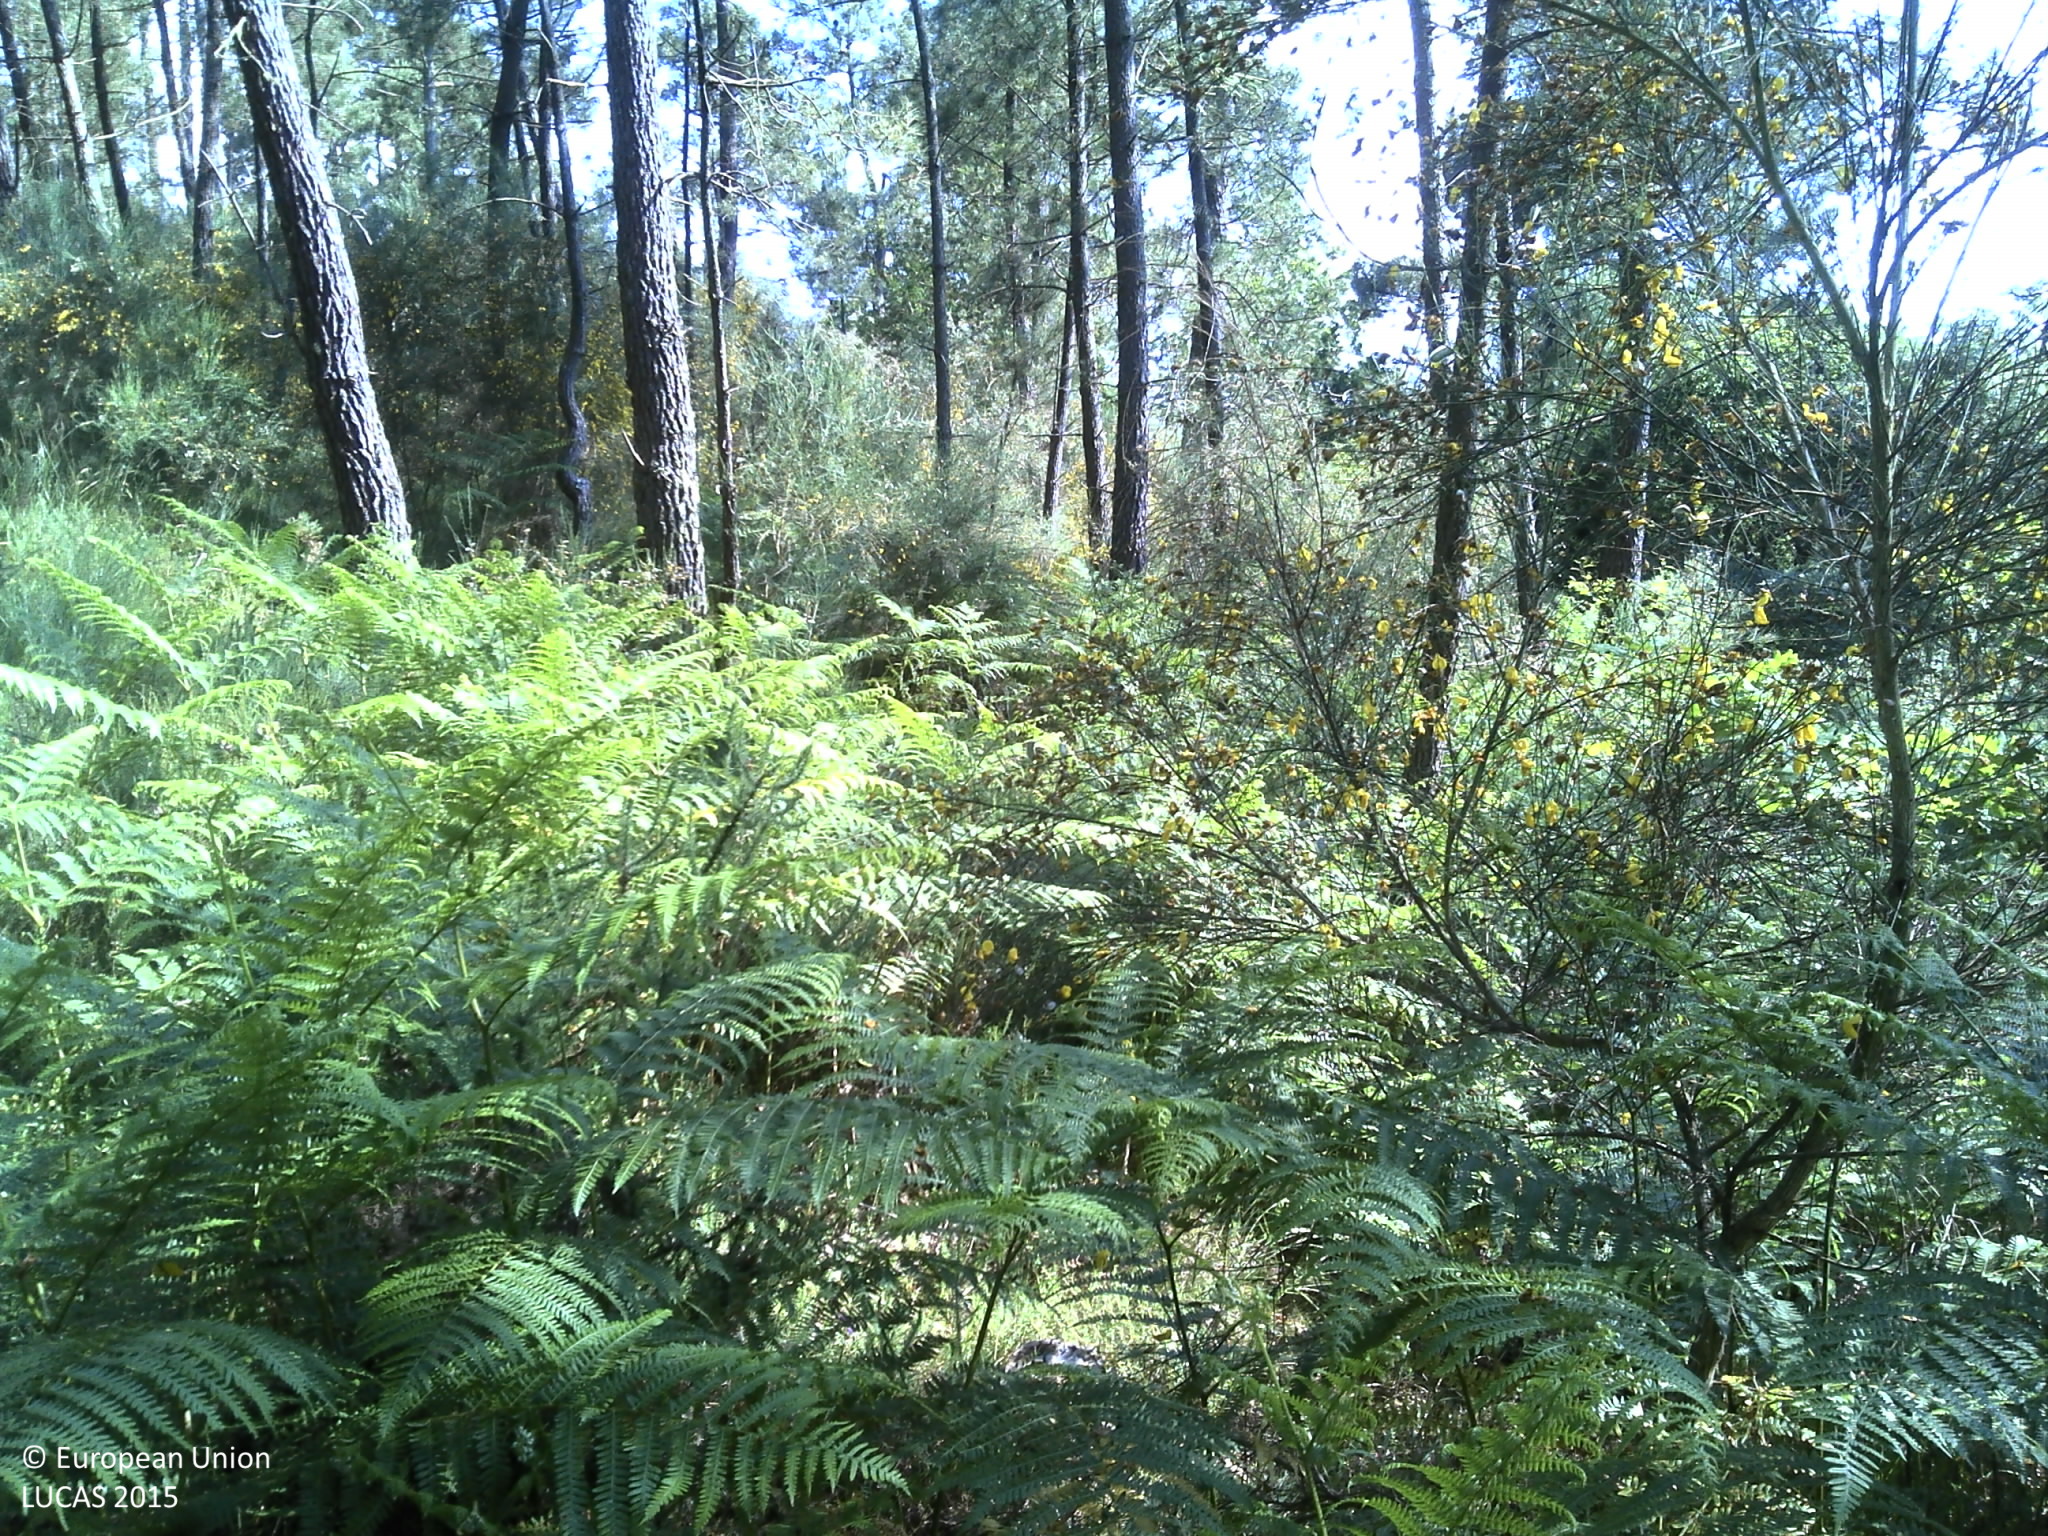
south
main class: Woodland
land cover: Pine dominated coniferous woodland
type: coniferous forest of the mediterranean region
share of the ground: > 75 %
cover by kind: coniferous forest trees 80 %, shrubs 20 %
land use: Forestry
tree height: > 5 m
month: June
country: PT
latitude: 42.0646
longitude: -8.2731
